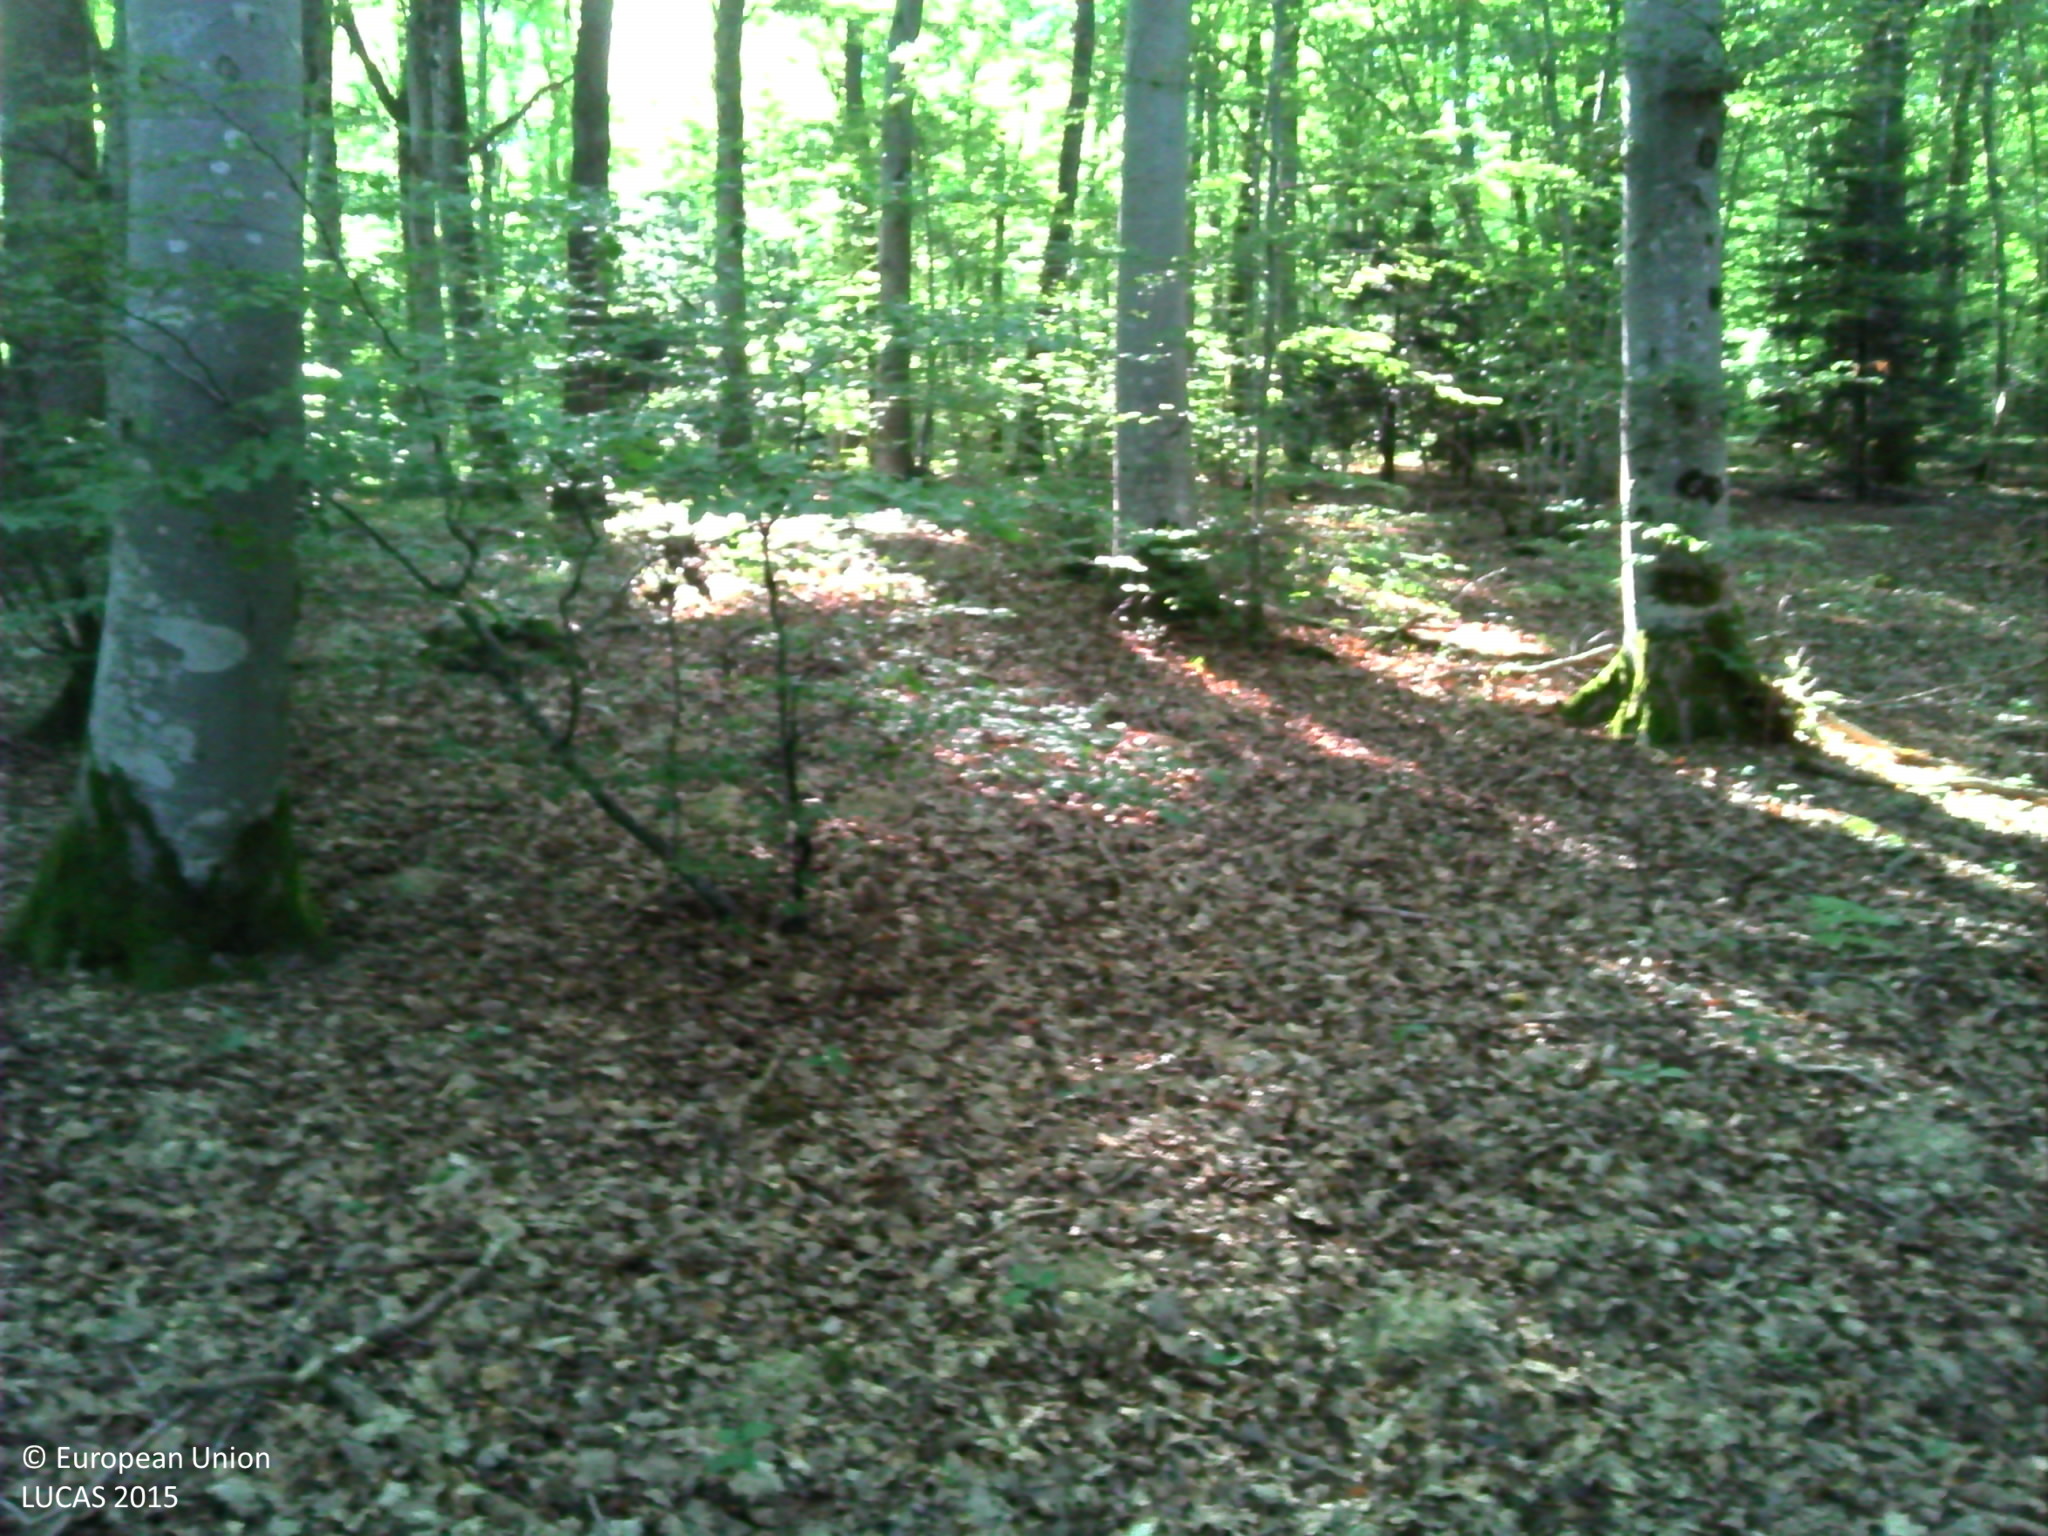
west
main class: Woodland
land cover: Broadleaved woodland
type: beech forest
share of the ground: > 75 %
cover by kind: broadleaved forest trees 90 %, coniferous forest trees 10 %
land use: Forestry
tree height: > 5 m
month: June
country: FR
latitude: 47.5224
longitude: 6.0569
